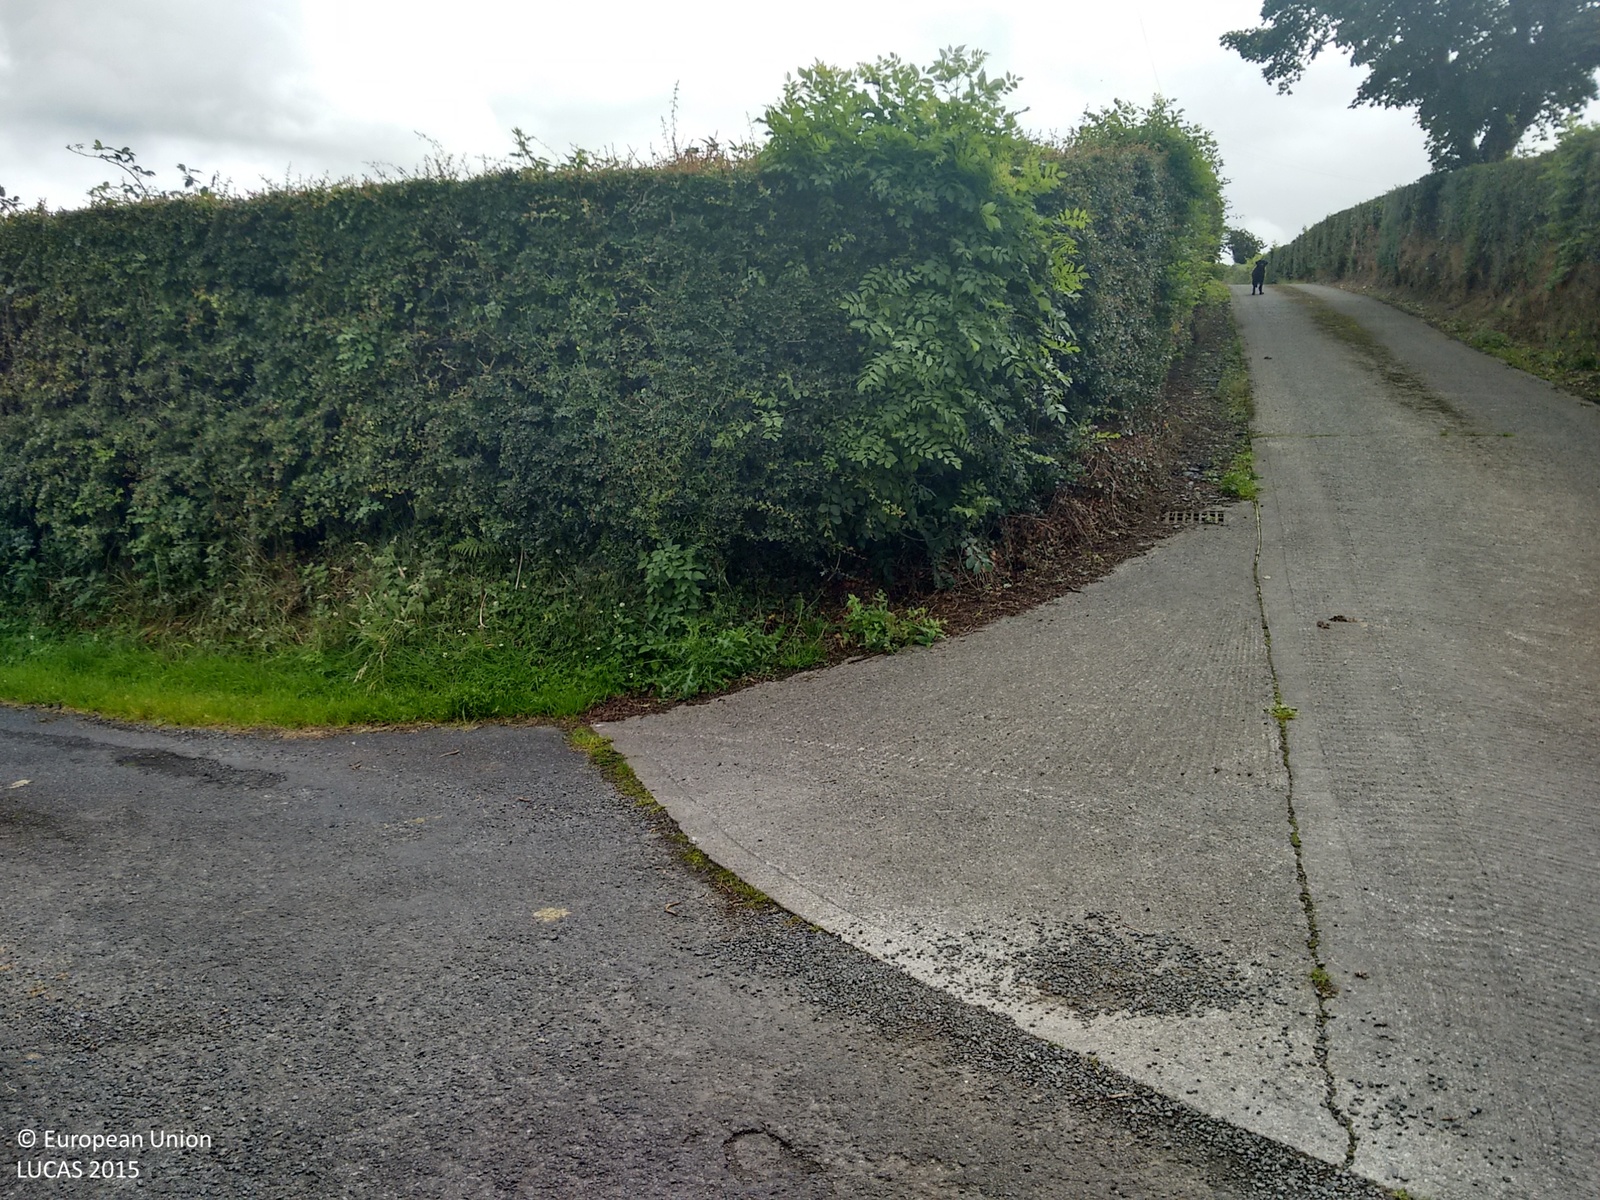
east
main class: Grassland
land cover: Grassland without tree/shrub cover
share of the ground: > 75 %
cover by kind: herbaceous plants 100 %
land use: Agriculture (excluding fallow land and kitchen gardens)
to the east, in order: Grassland without tree/shrub cover; Managed hedges; Grass margins; Paved roads, cycling and walking lanes; Grass margins; Electric lines; Artificial constructions in urban areas; Grassland without tree/shrub cover; Managed hedges; Grassland without tree/shrub cover; Managed hedges; Grassland without tree/shrub cover; Managed hedges; Grassland without tree/shrub cover
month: August
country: GB
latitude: 54.2849
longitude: -6.7370
